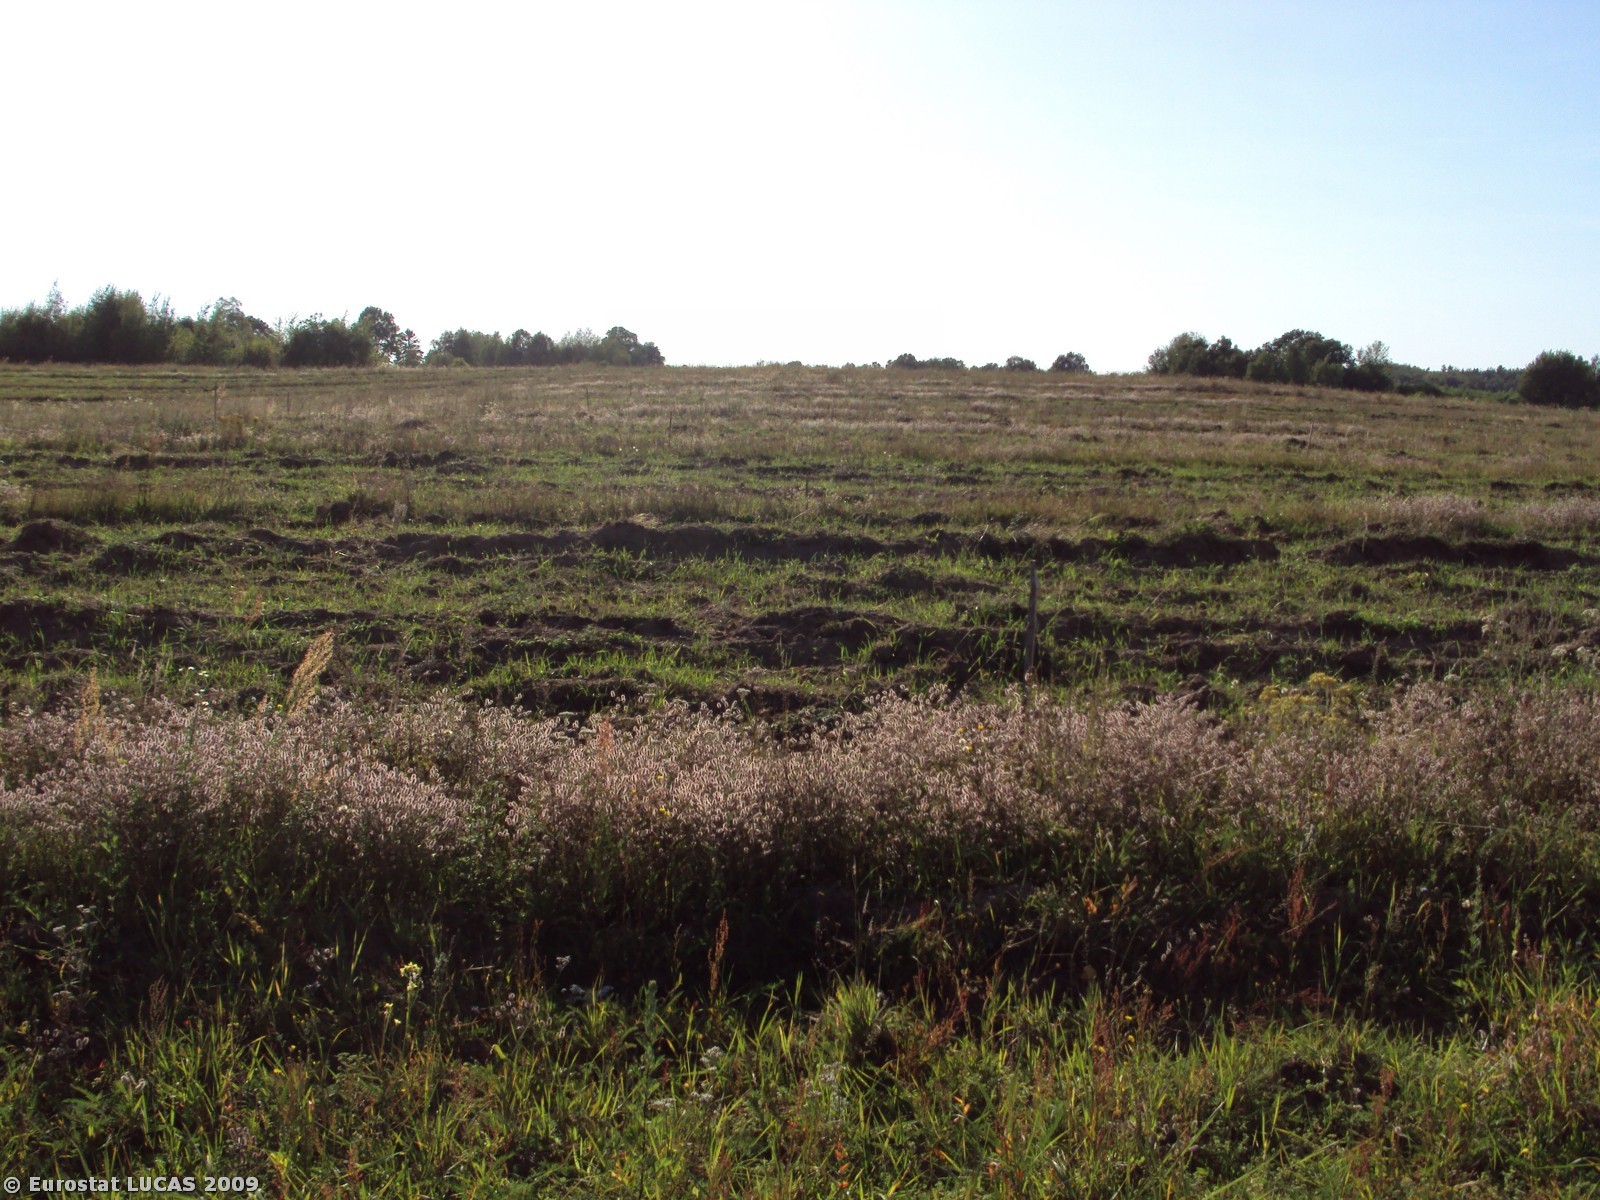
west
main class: Grassland
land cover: Spontaneously vegetated surfaces
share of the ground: > 75 %
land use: Fallow land
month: August
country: PL
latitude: 53.7789
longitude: 16.6387
